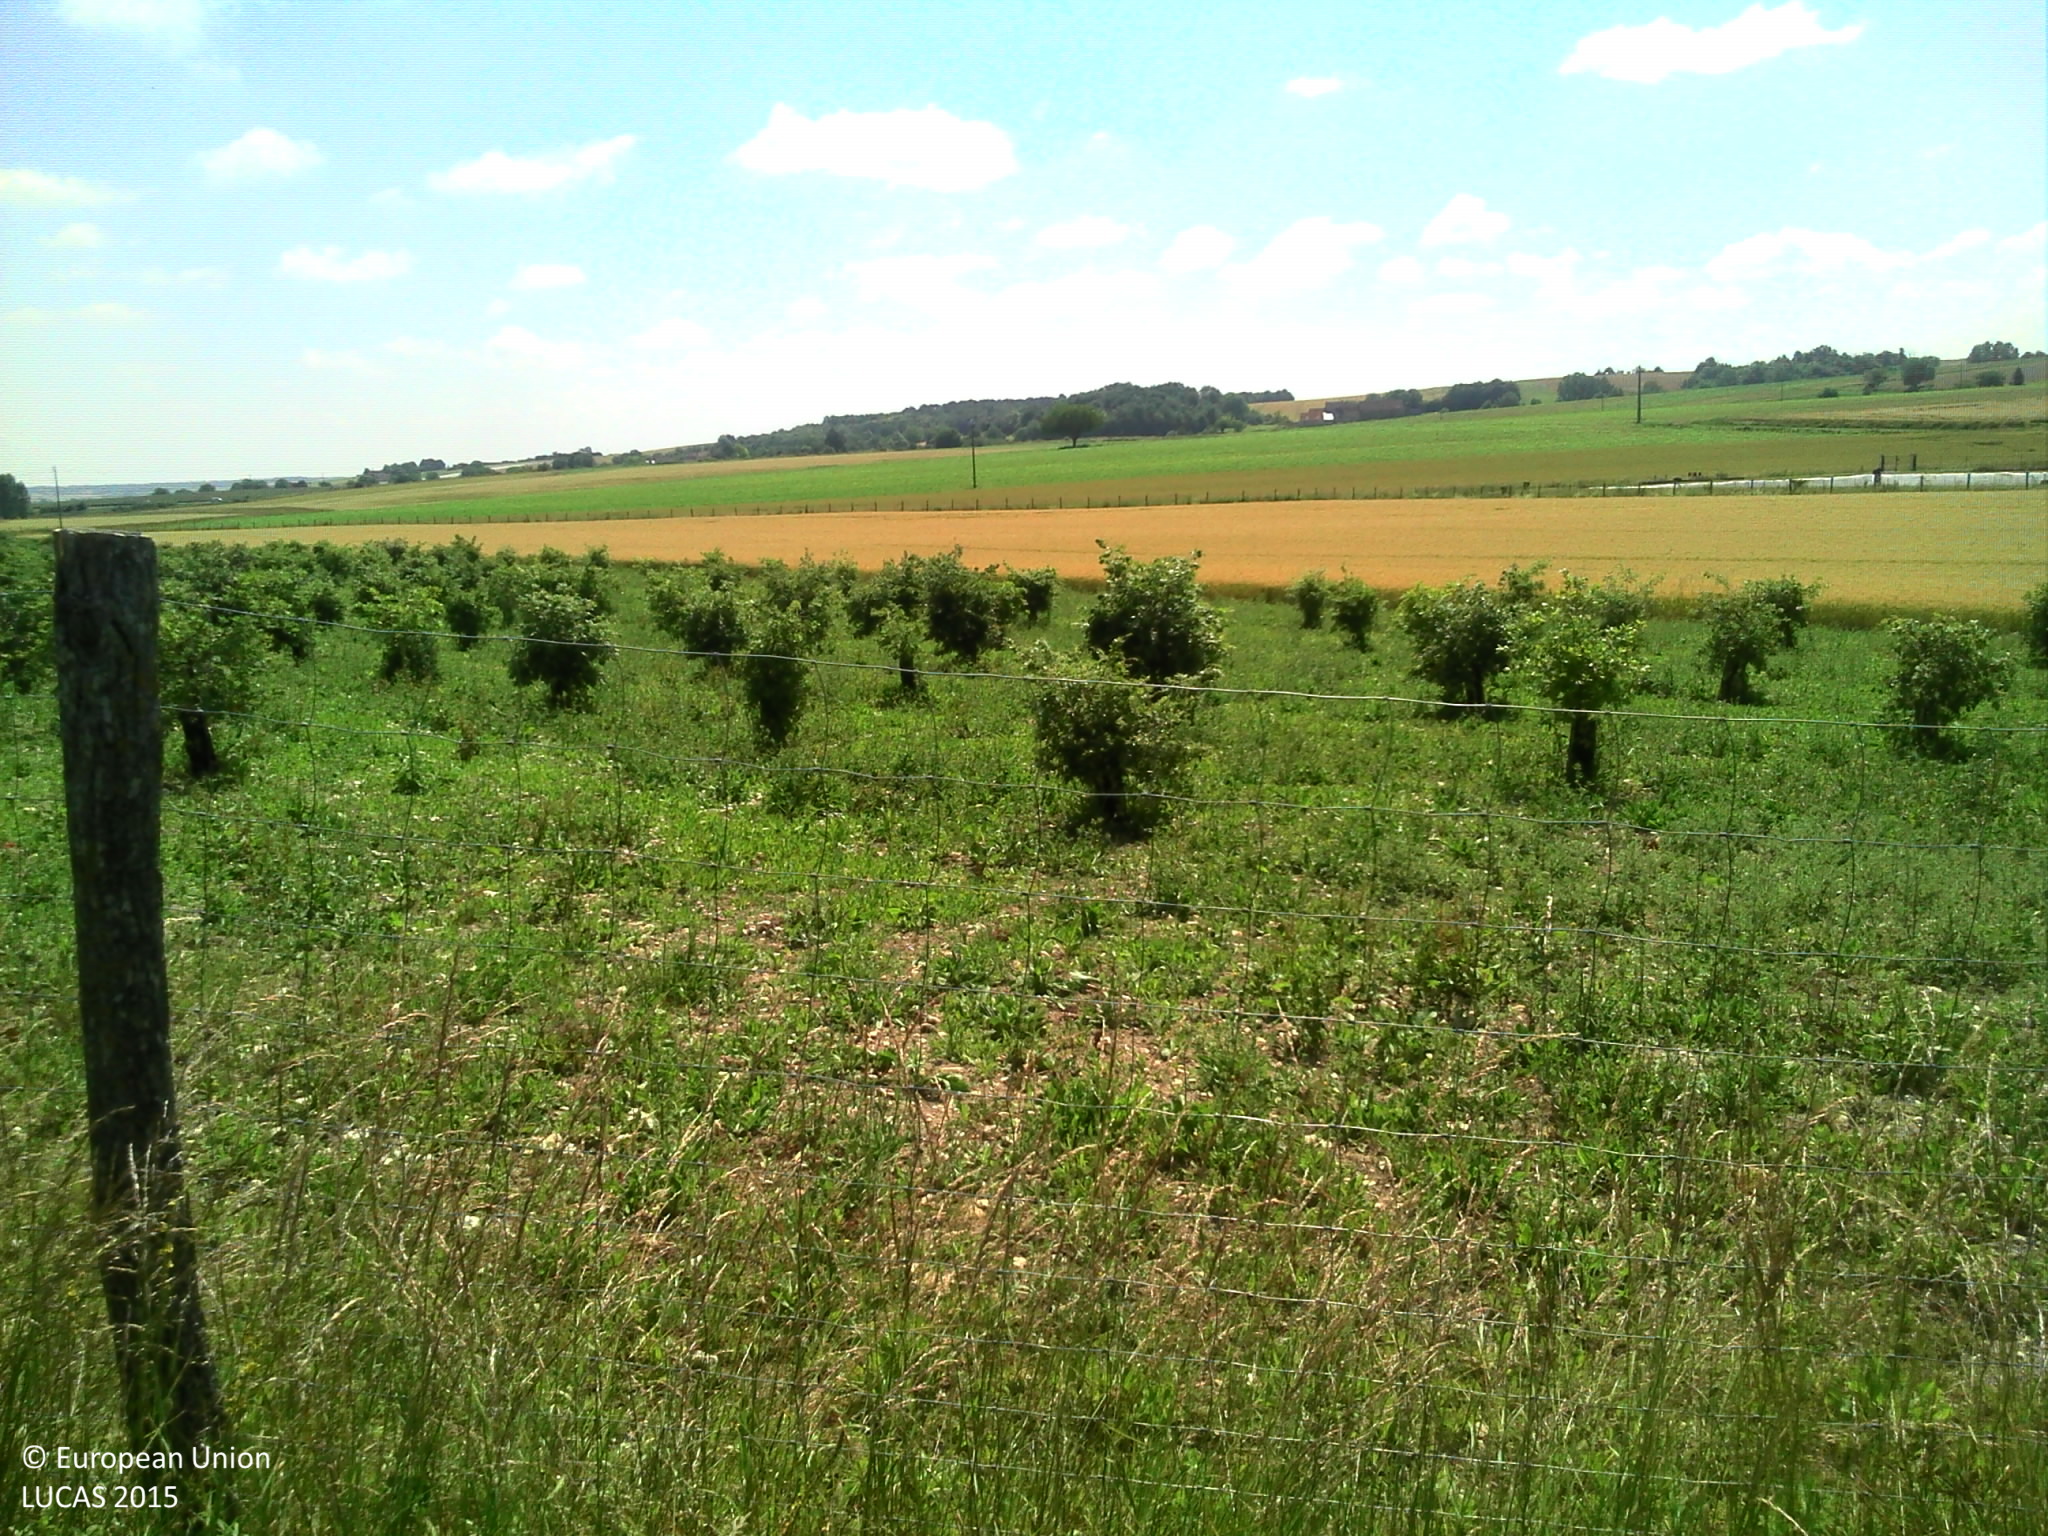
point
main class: Woodland
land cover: Broadleaved woodland
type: exotic forest
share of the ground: 25 - 50 %
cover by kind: herbaceous plants 65 %, broadleaved forest trees 25 %, unconsolidated bare surface 10 %
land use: Forestry
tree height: < 5 m
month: June
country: FR
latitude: 46.9457
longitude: 0.5349
